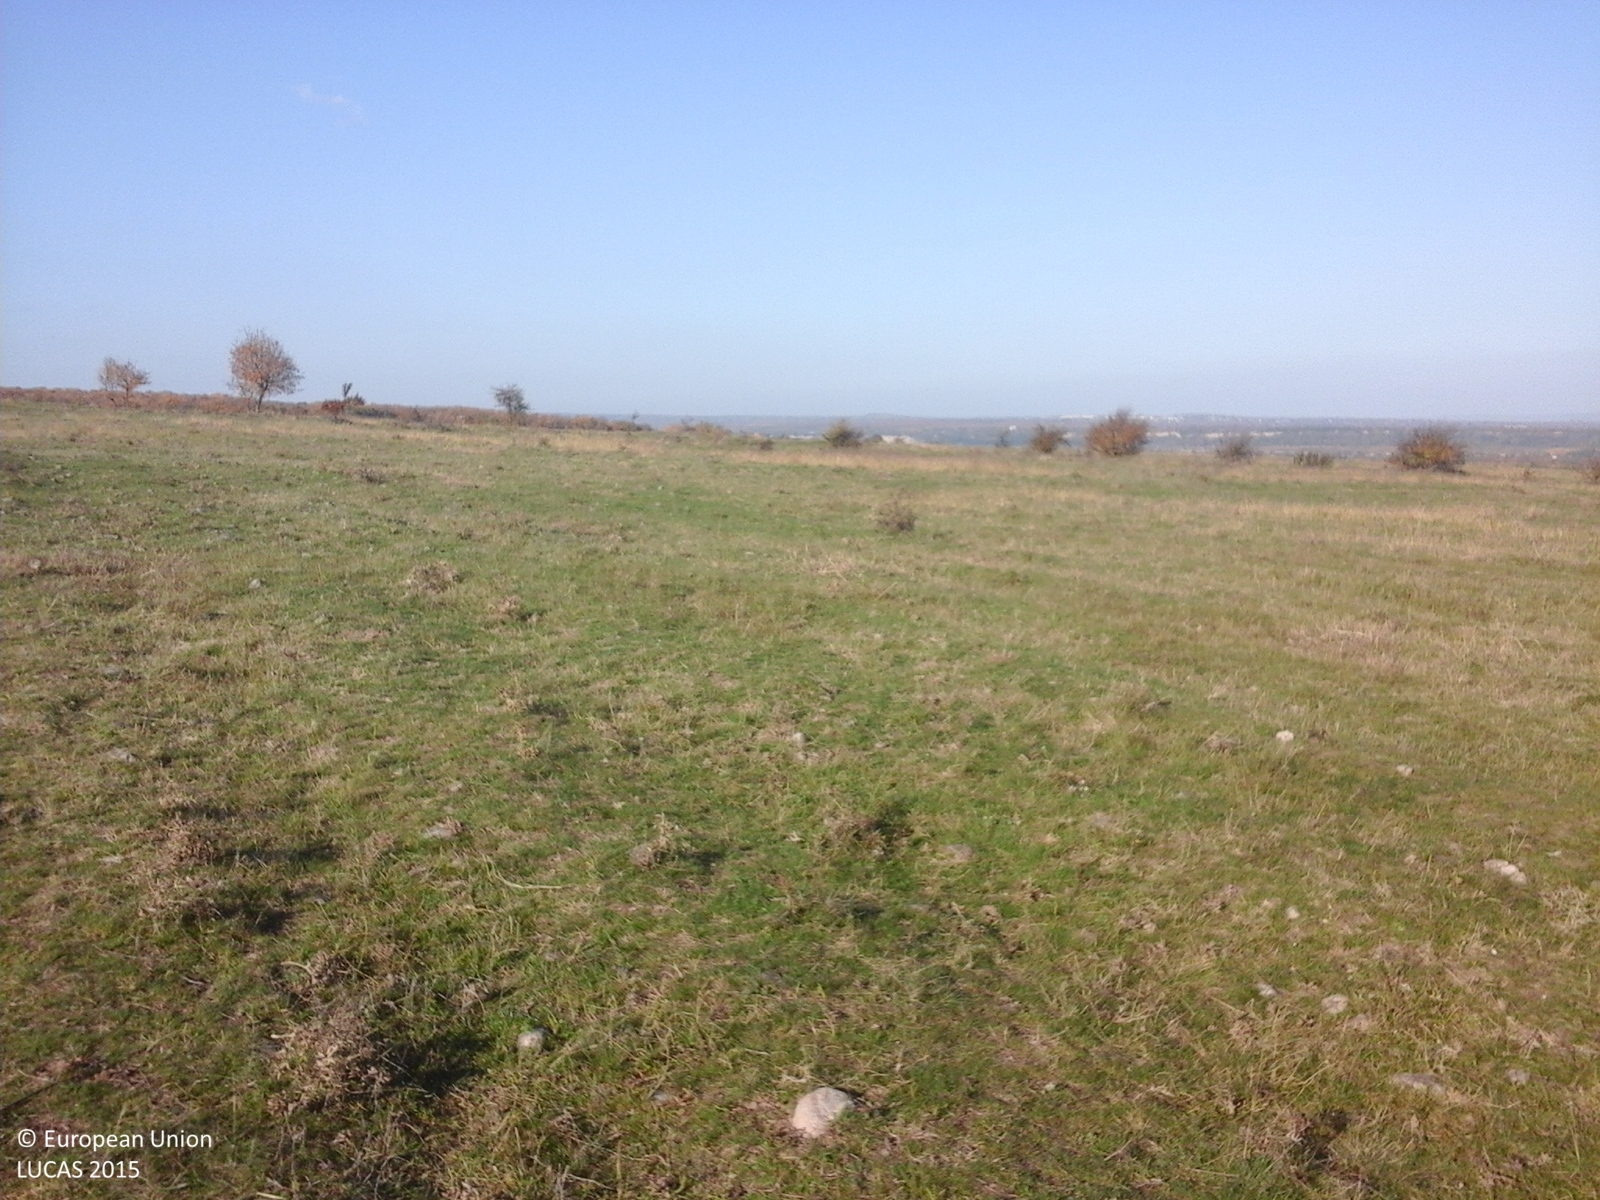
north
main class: Grassland
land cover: Grassland without tree/shrub cover
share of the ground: > 75 %
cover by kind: herbaceous plants 100 %
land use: Agriculture (excluding fallow land and kitchen gardens)
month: October
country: RO
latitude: 45.8167
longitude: 27.0415
